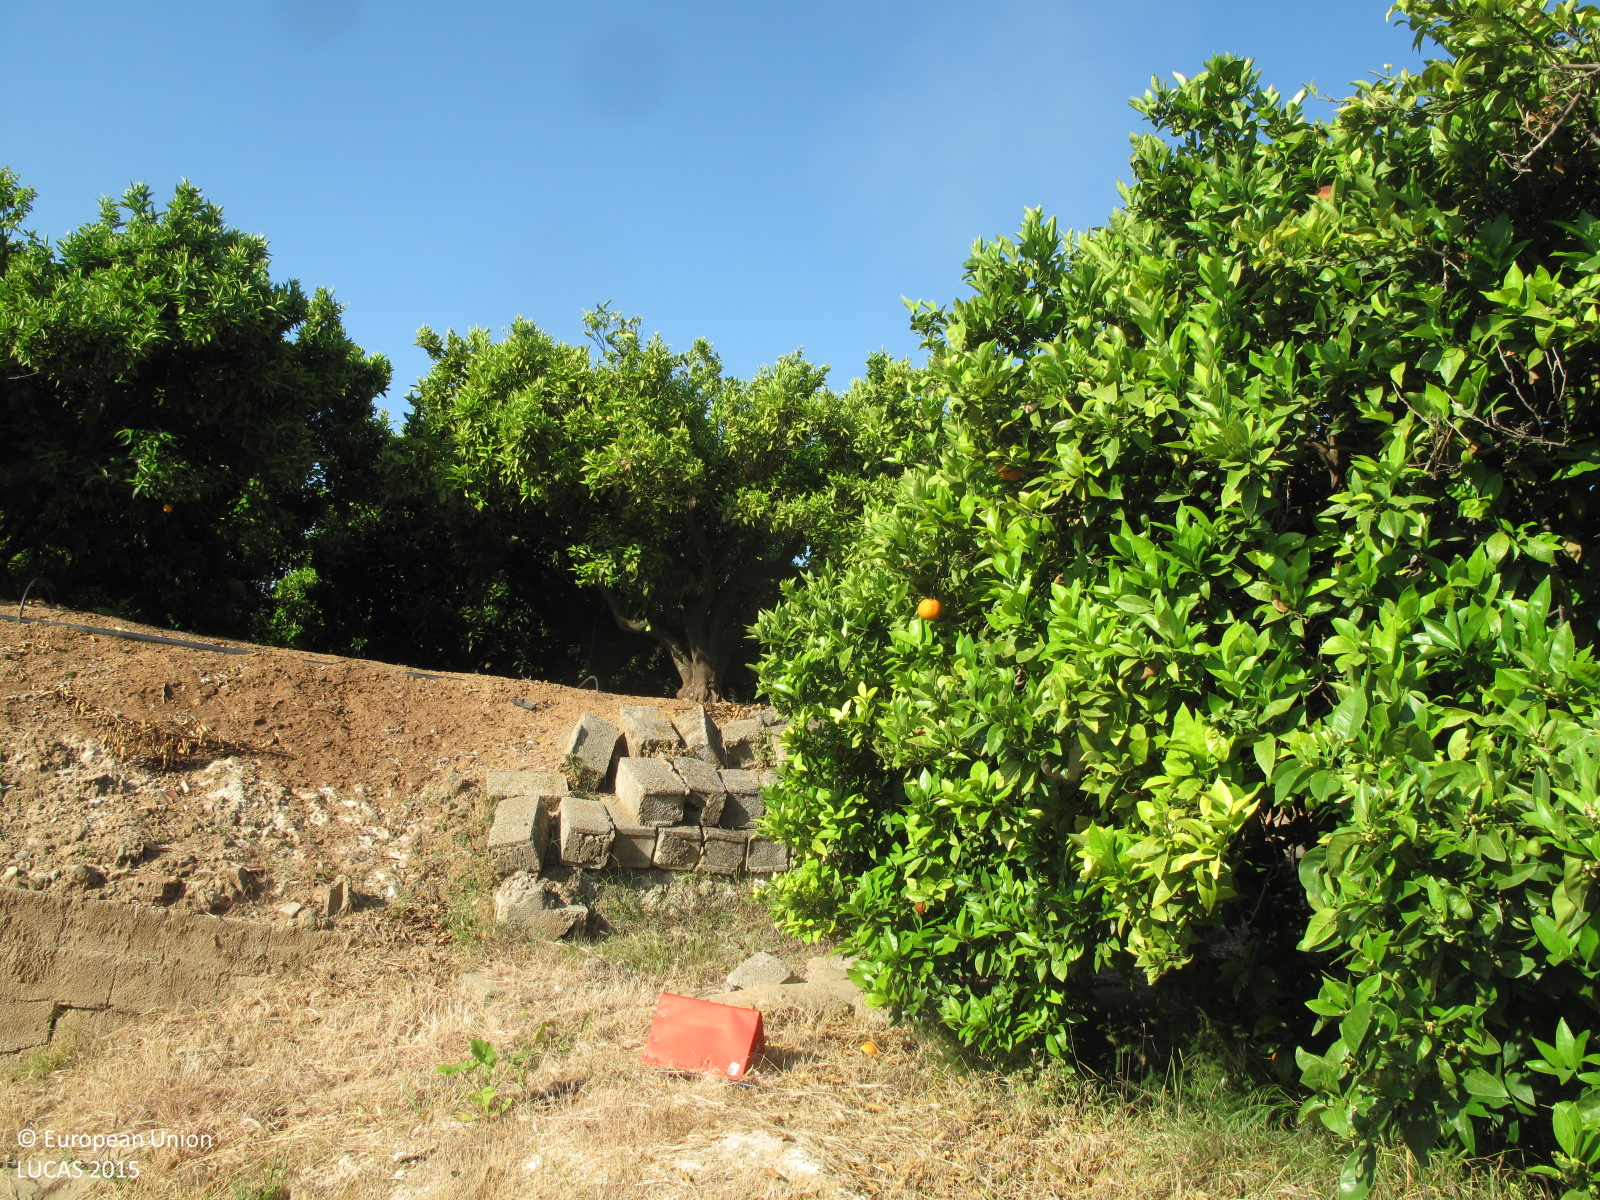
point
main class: Cropland
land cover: Oranges
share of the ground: > 75 %
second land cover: Spontaneously vegetated surfaces
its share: 25 - 50 %
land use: Agriculture (excluding fallow land and kitchen gardens)
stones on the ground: < 10 %
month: May
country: ES
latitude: 39.0002
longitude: -0.5815
